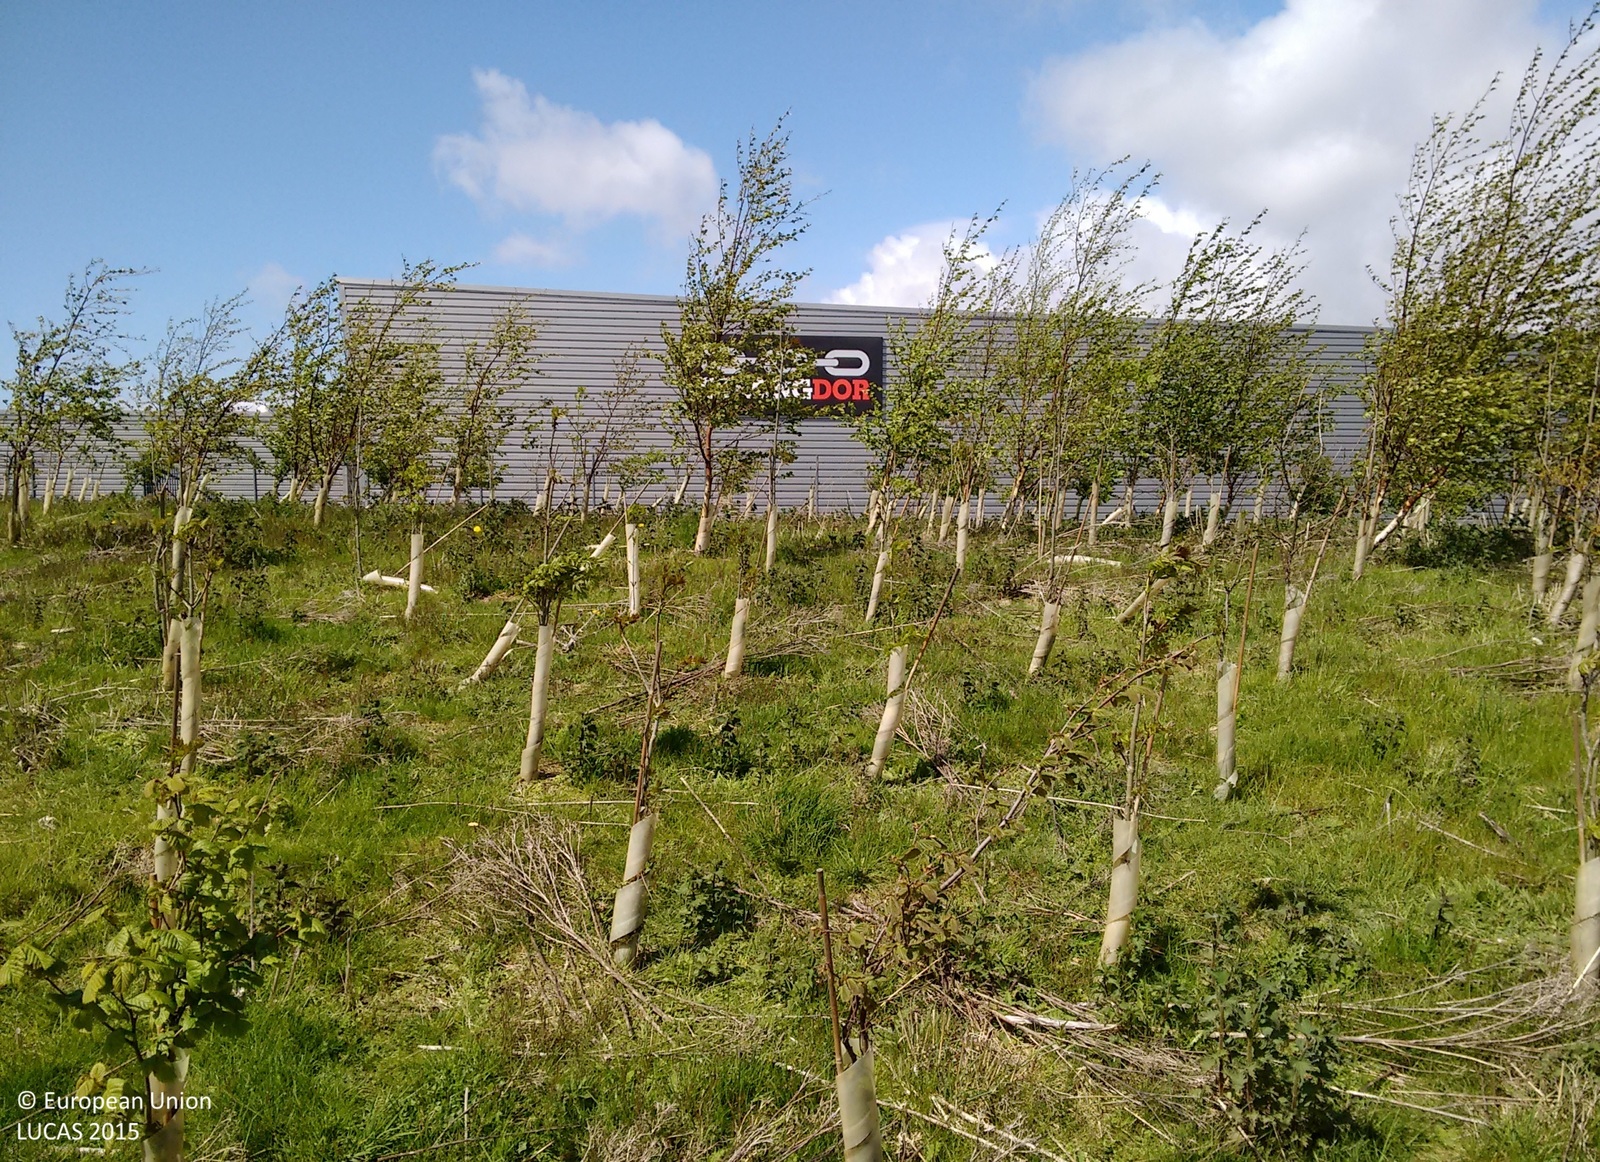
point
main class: Woodland
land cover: Broadleaved woodland
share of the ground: 50 - 75 %
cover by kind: broadleaved forest trees 100 %
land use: Agriculture (excluding fallow land and kitchen gardens)
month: May
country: GB
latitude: 54.1266
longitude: -2.7543
